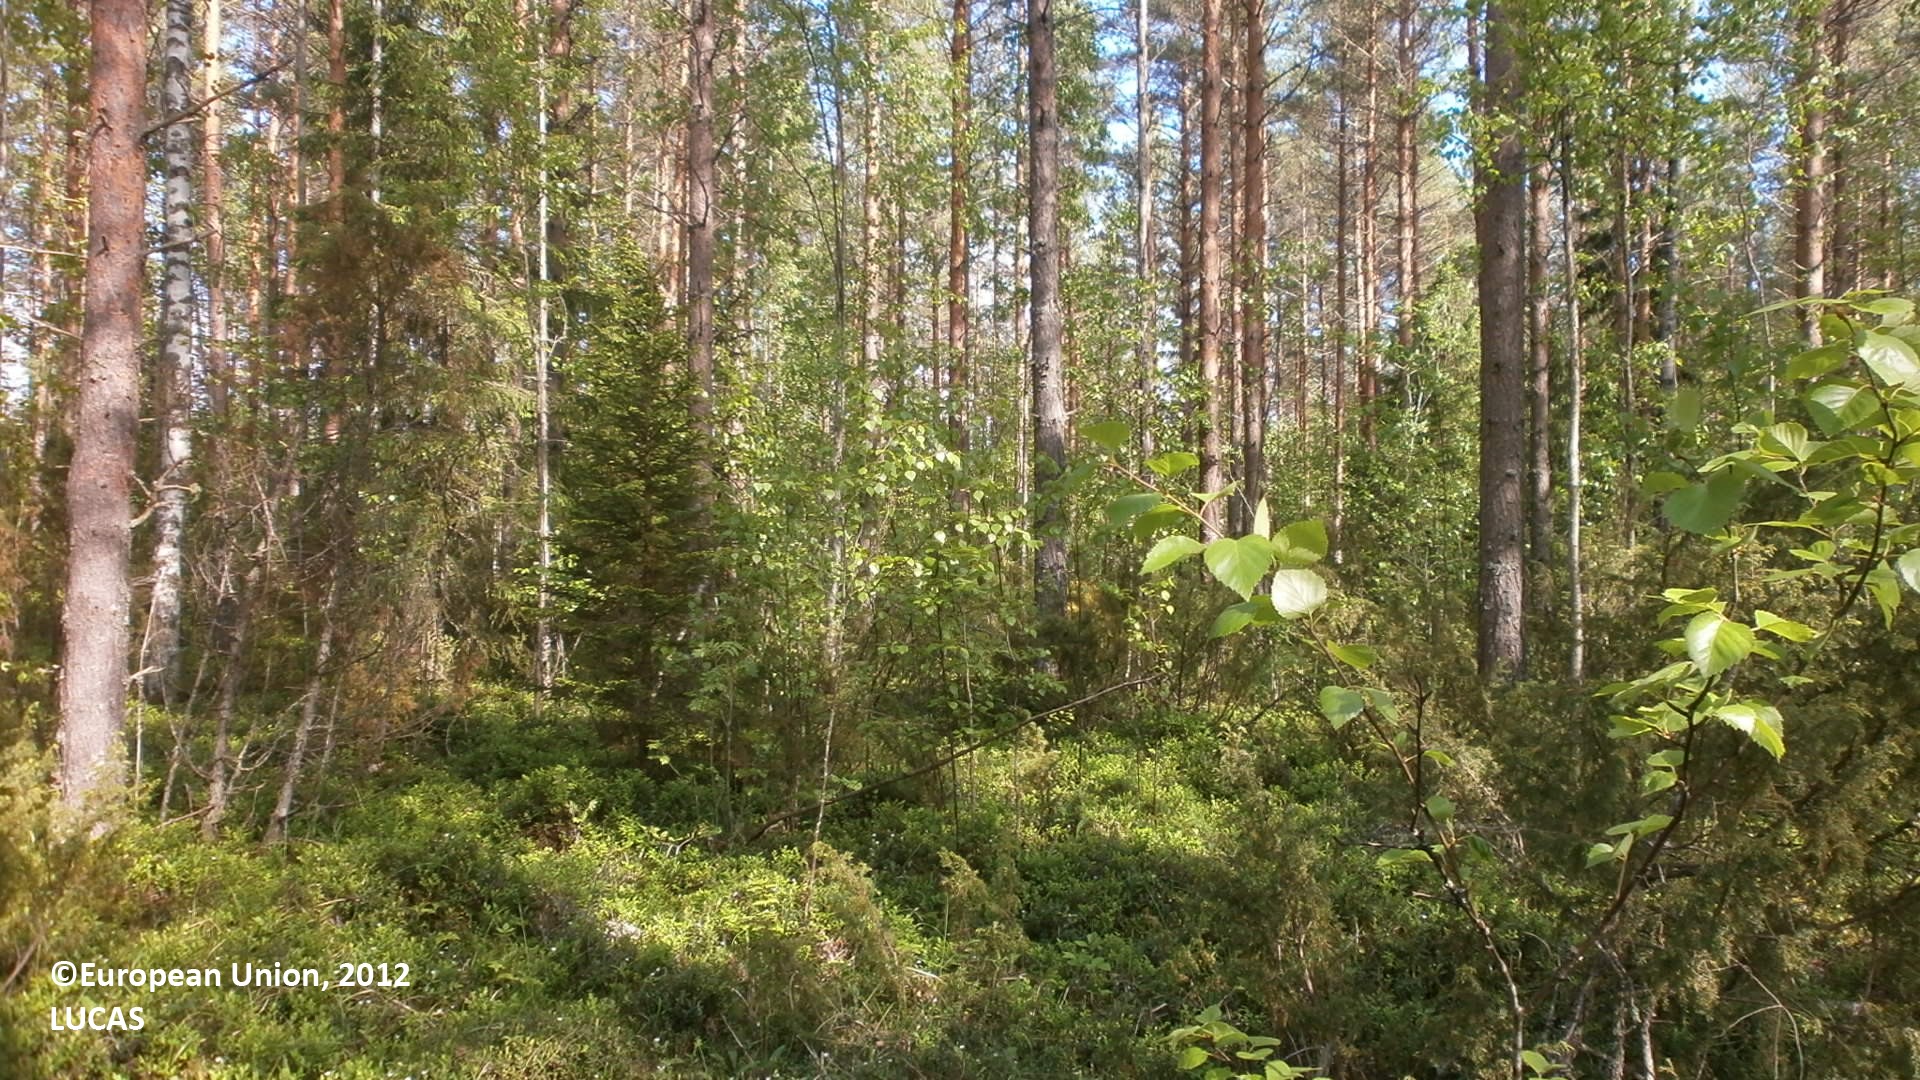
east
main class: Woodland
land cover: Pine dominated coniferous woodland
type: hemiboreal forest and nemoral coniferous forest and mixed broadleaved-coniferous forest
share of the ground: 50 - 75 %
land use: Forestry
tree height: > 5 m
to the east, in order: Pine dominated coniferous woodland; Other coniferous woodland; Pine dominated coniferous woodland; Other mixed woodland; Ditches and canals; Spruce dominated coniferous woodland; Pine dominated coniferous woodland; Other mixed woodland; Ditches and canals; Pine dominated coniferous woodland
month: June
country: FI
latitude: 64.0543
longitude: 25.6892
